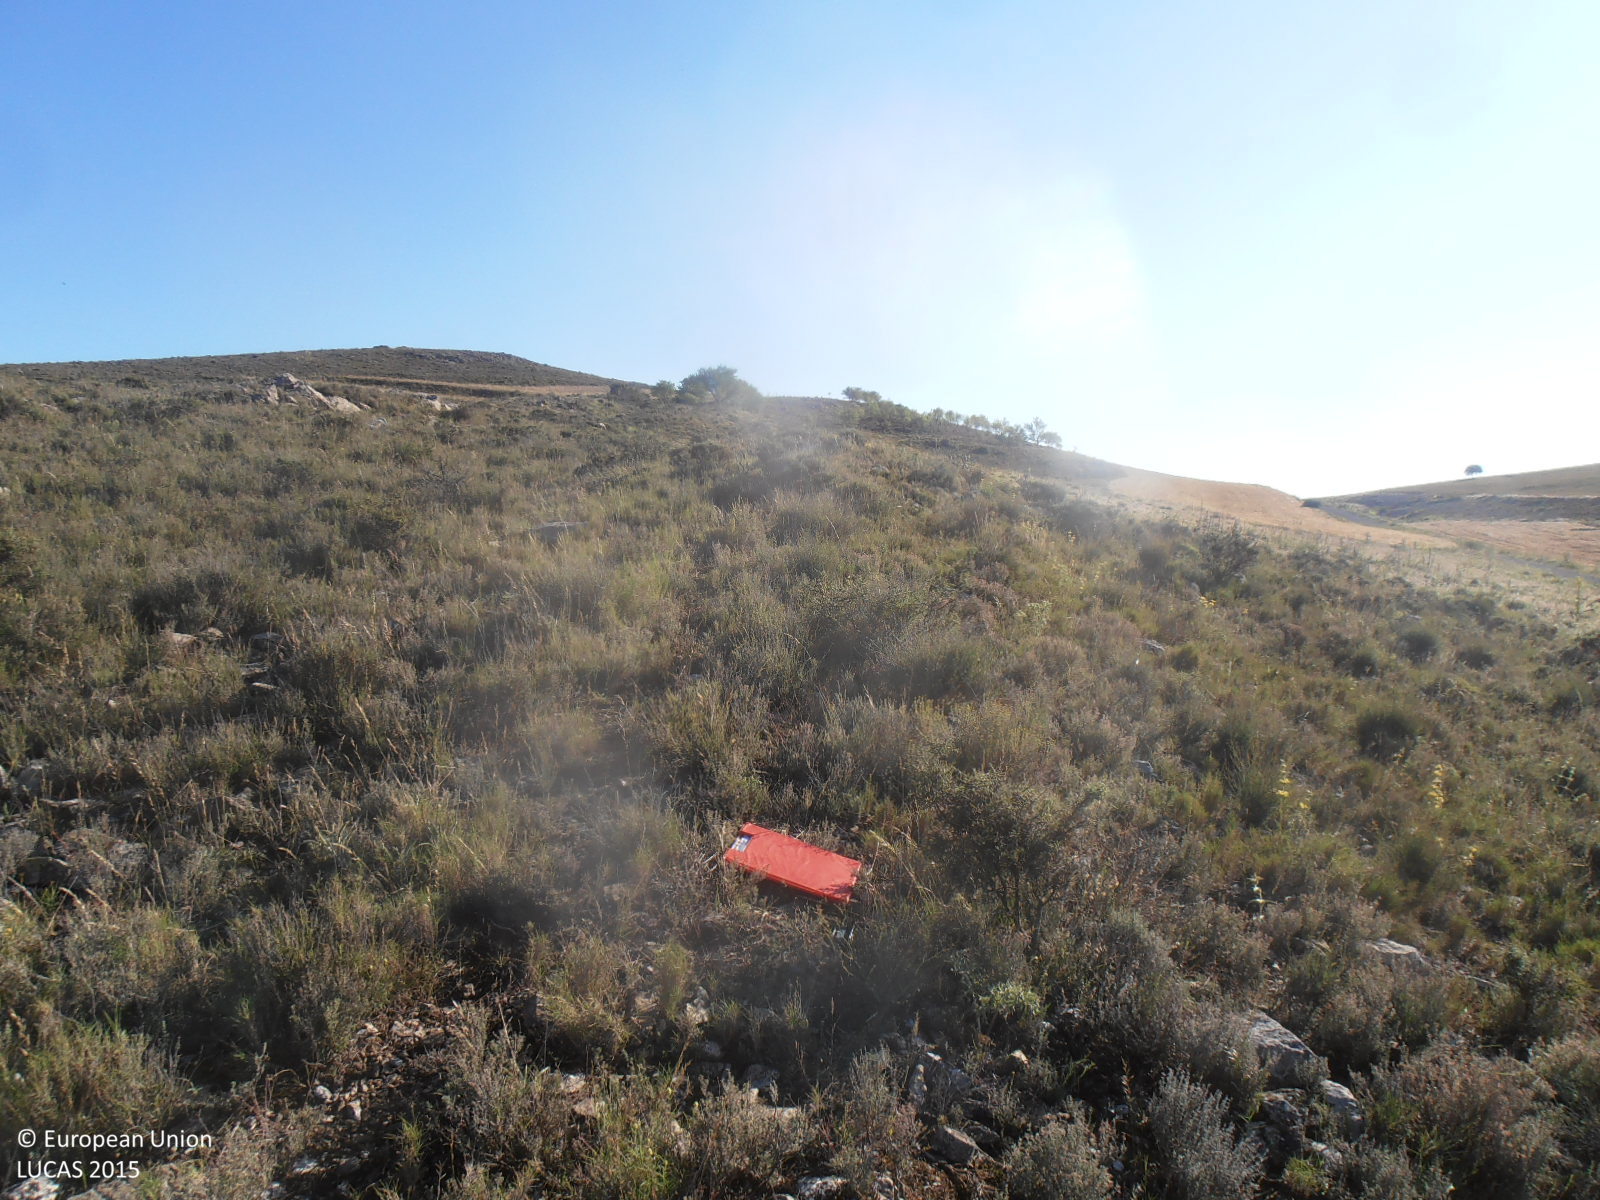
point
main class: Shrubland
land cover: Shrubland without tree cover
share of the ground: > 75 %
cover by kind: shrubs 80 %, herbaceous plants 10 %, consolidated bare surface 10 %
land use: Semi-natural and natural areas not in use
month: June
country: ES
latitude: 41.8325
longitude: -1.9661
